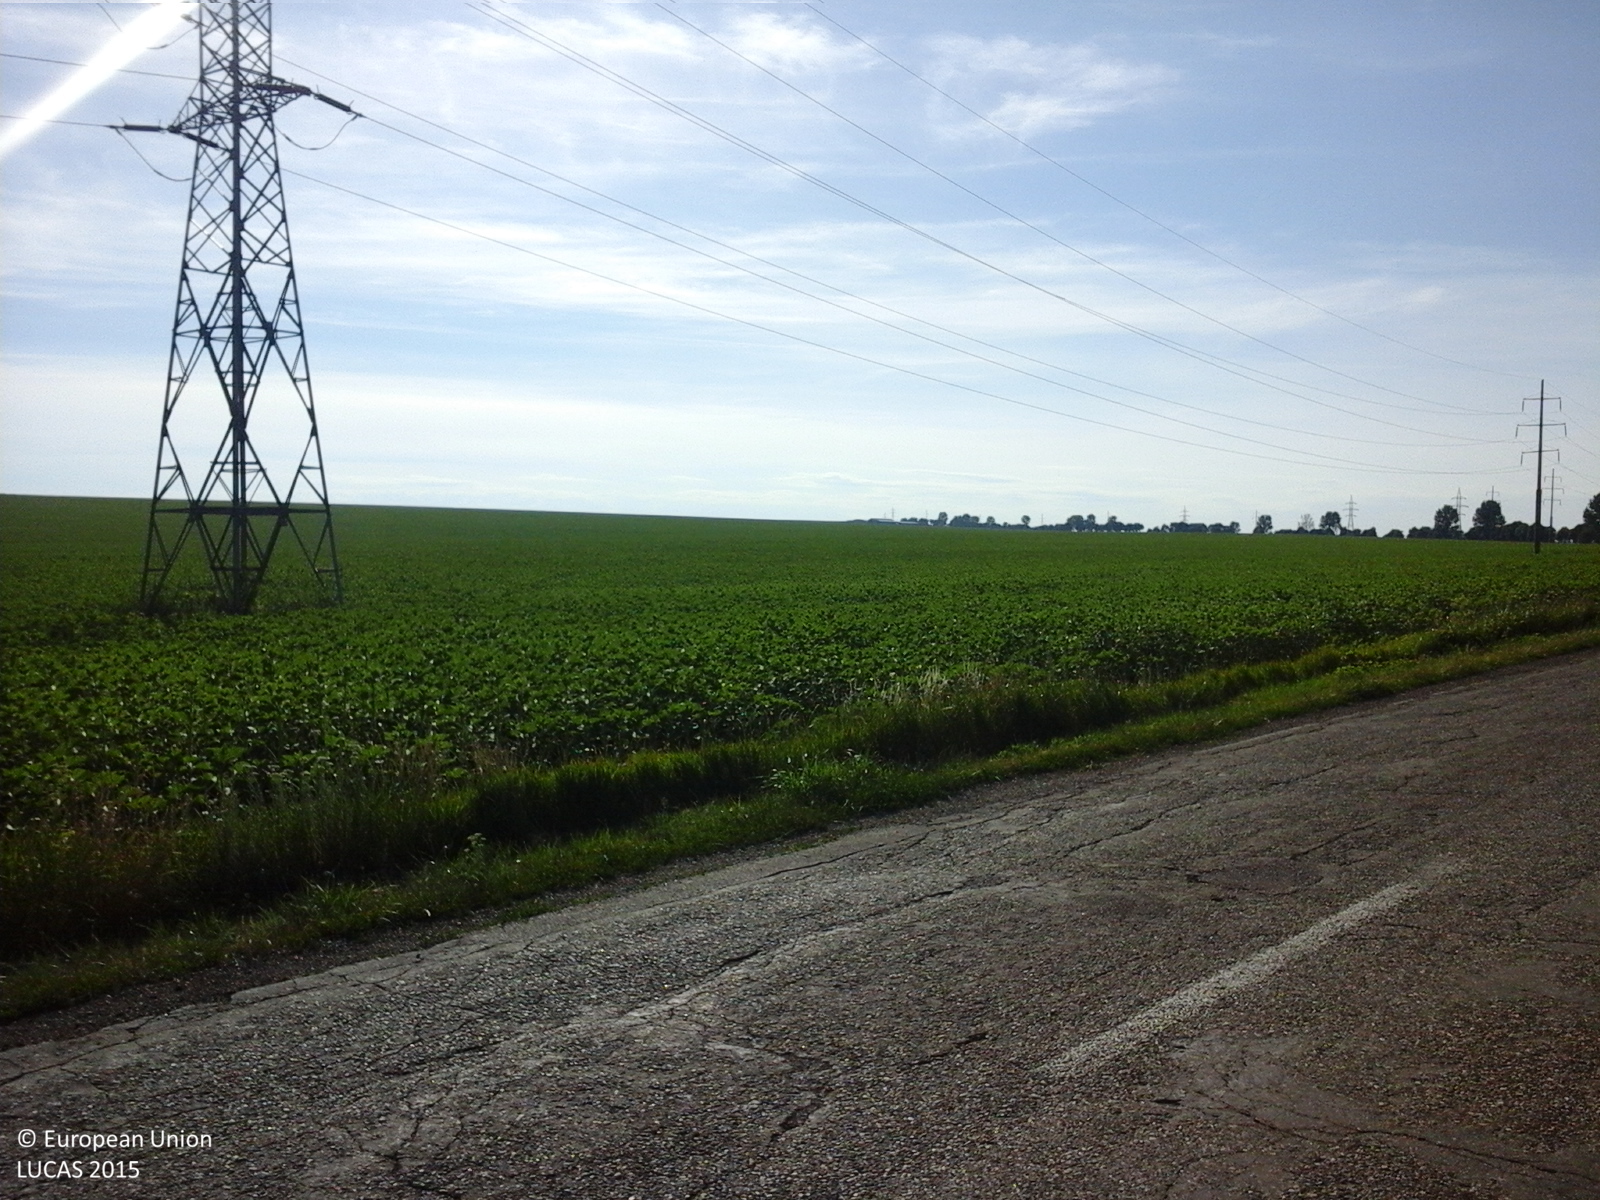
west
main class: Cropland
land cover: Common wheat
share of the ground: > 75 %
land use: Agriculture (excluding fallow land and kitchen gardens)
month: June
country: RO
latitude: 47.8939
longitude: 27.1641
